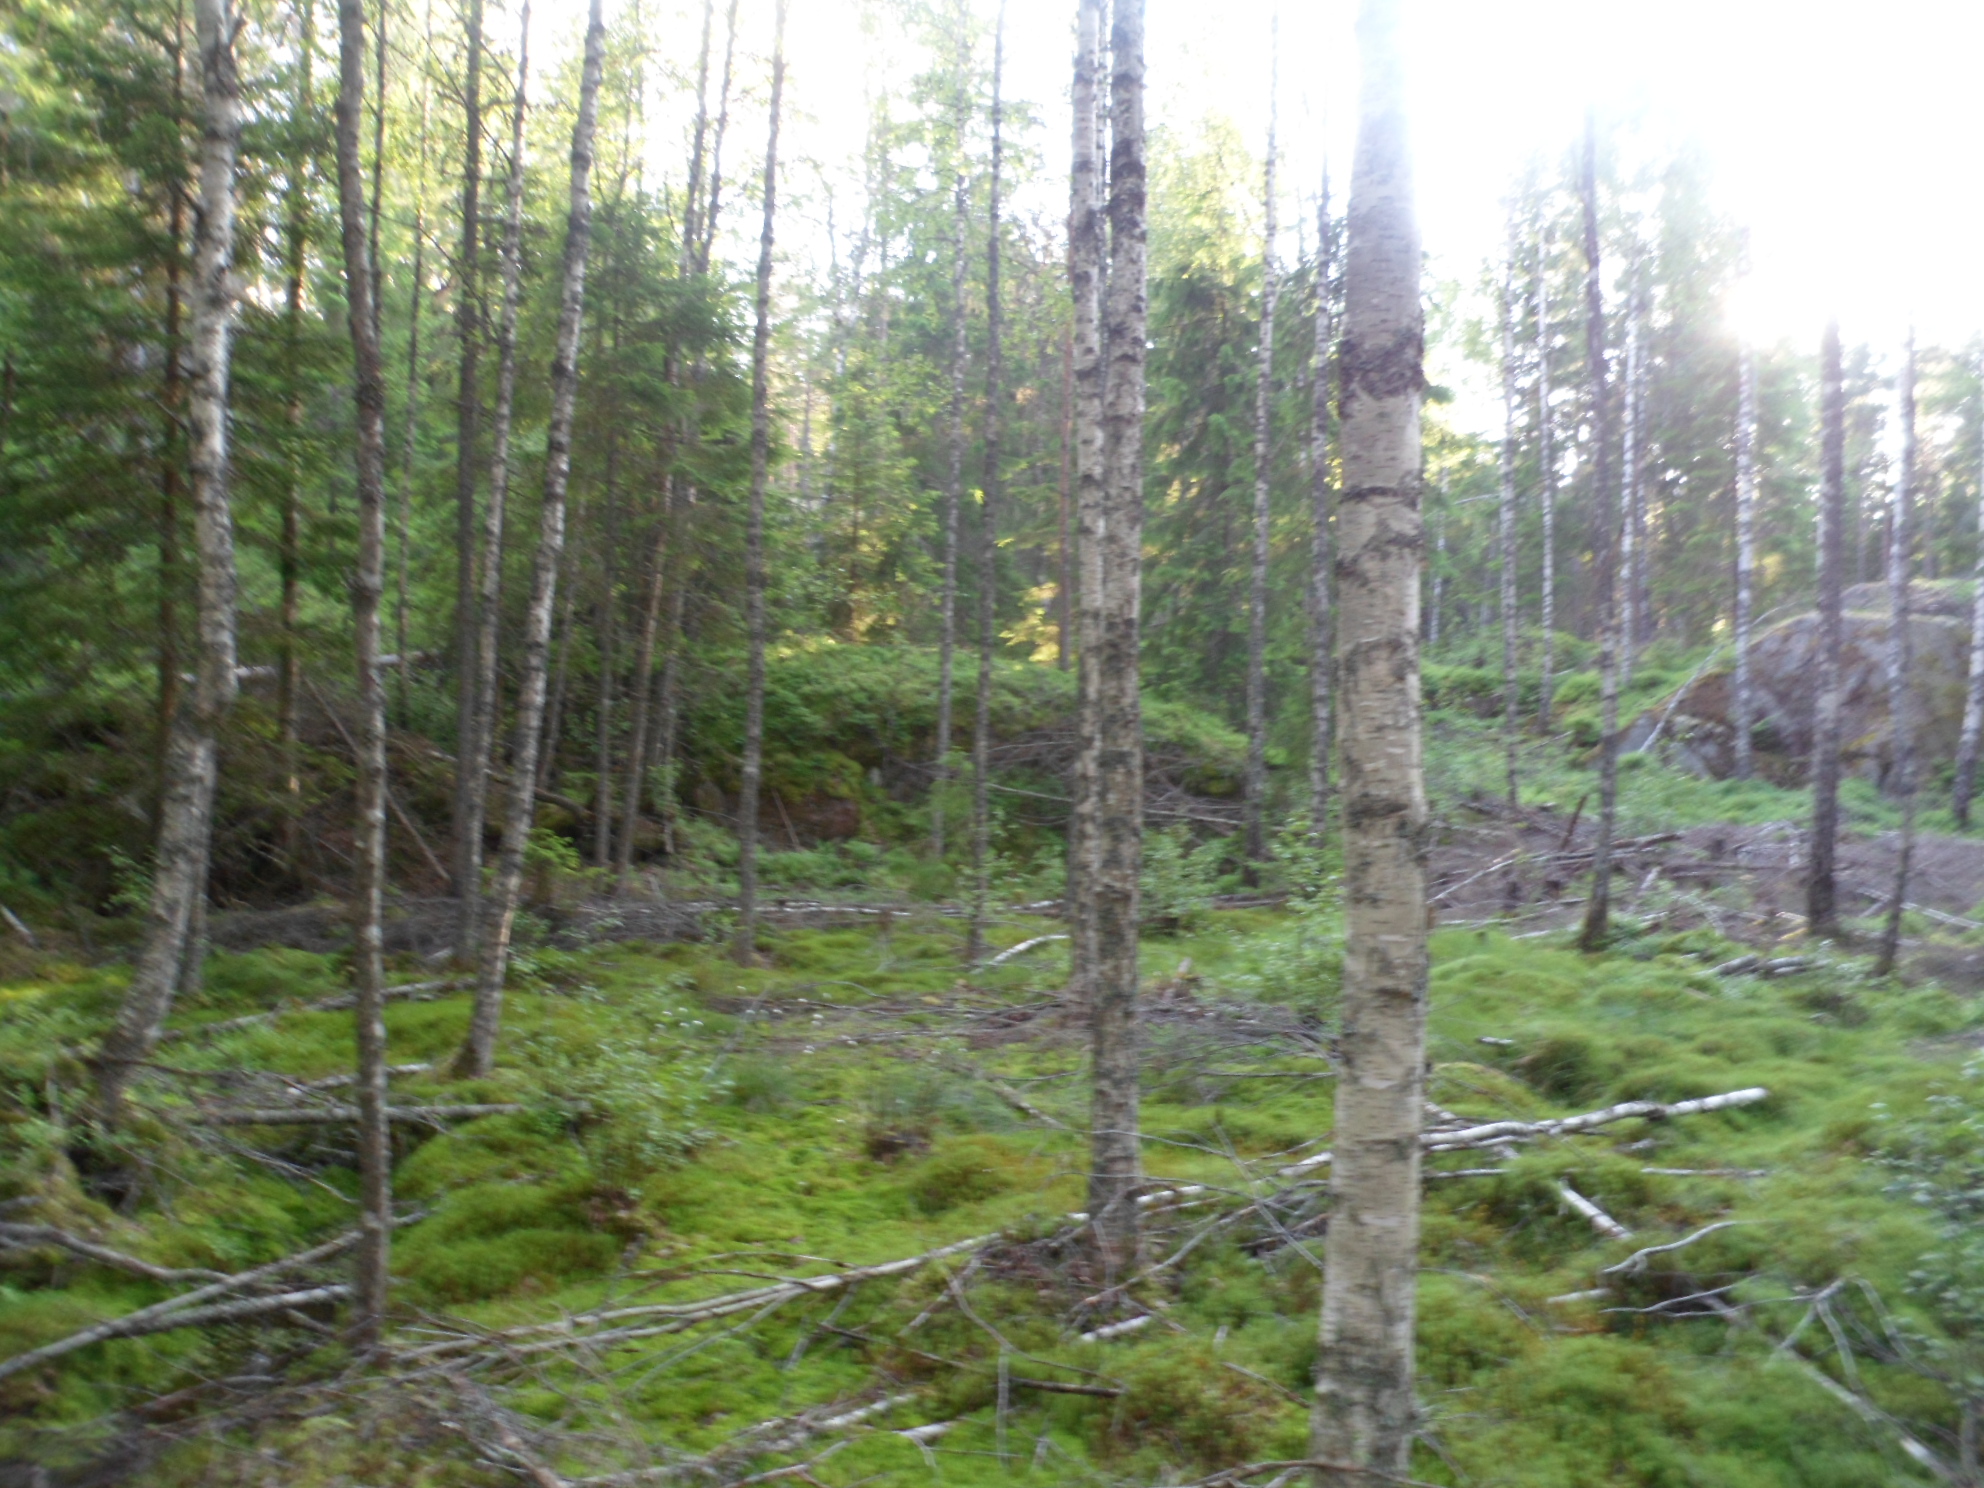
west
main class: Woodland
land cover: Spruce dominated mixed woodland
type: boreal forest
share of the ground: 50 - 75 %
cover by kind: broadleaved forest trees 35 %, coniferous forest trees 25 %, lichens and mosses 25 %, shrubs 10 %, herbaceous plants 5 %
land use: Forestry
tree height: > 5 m
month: June
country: SE
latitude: 57.1135
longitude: 15.0996
